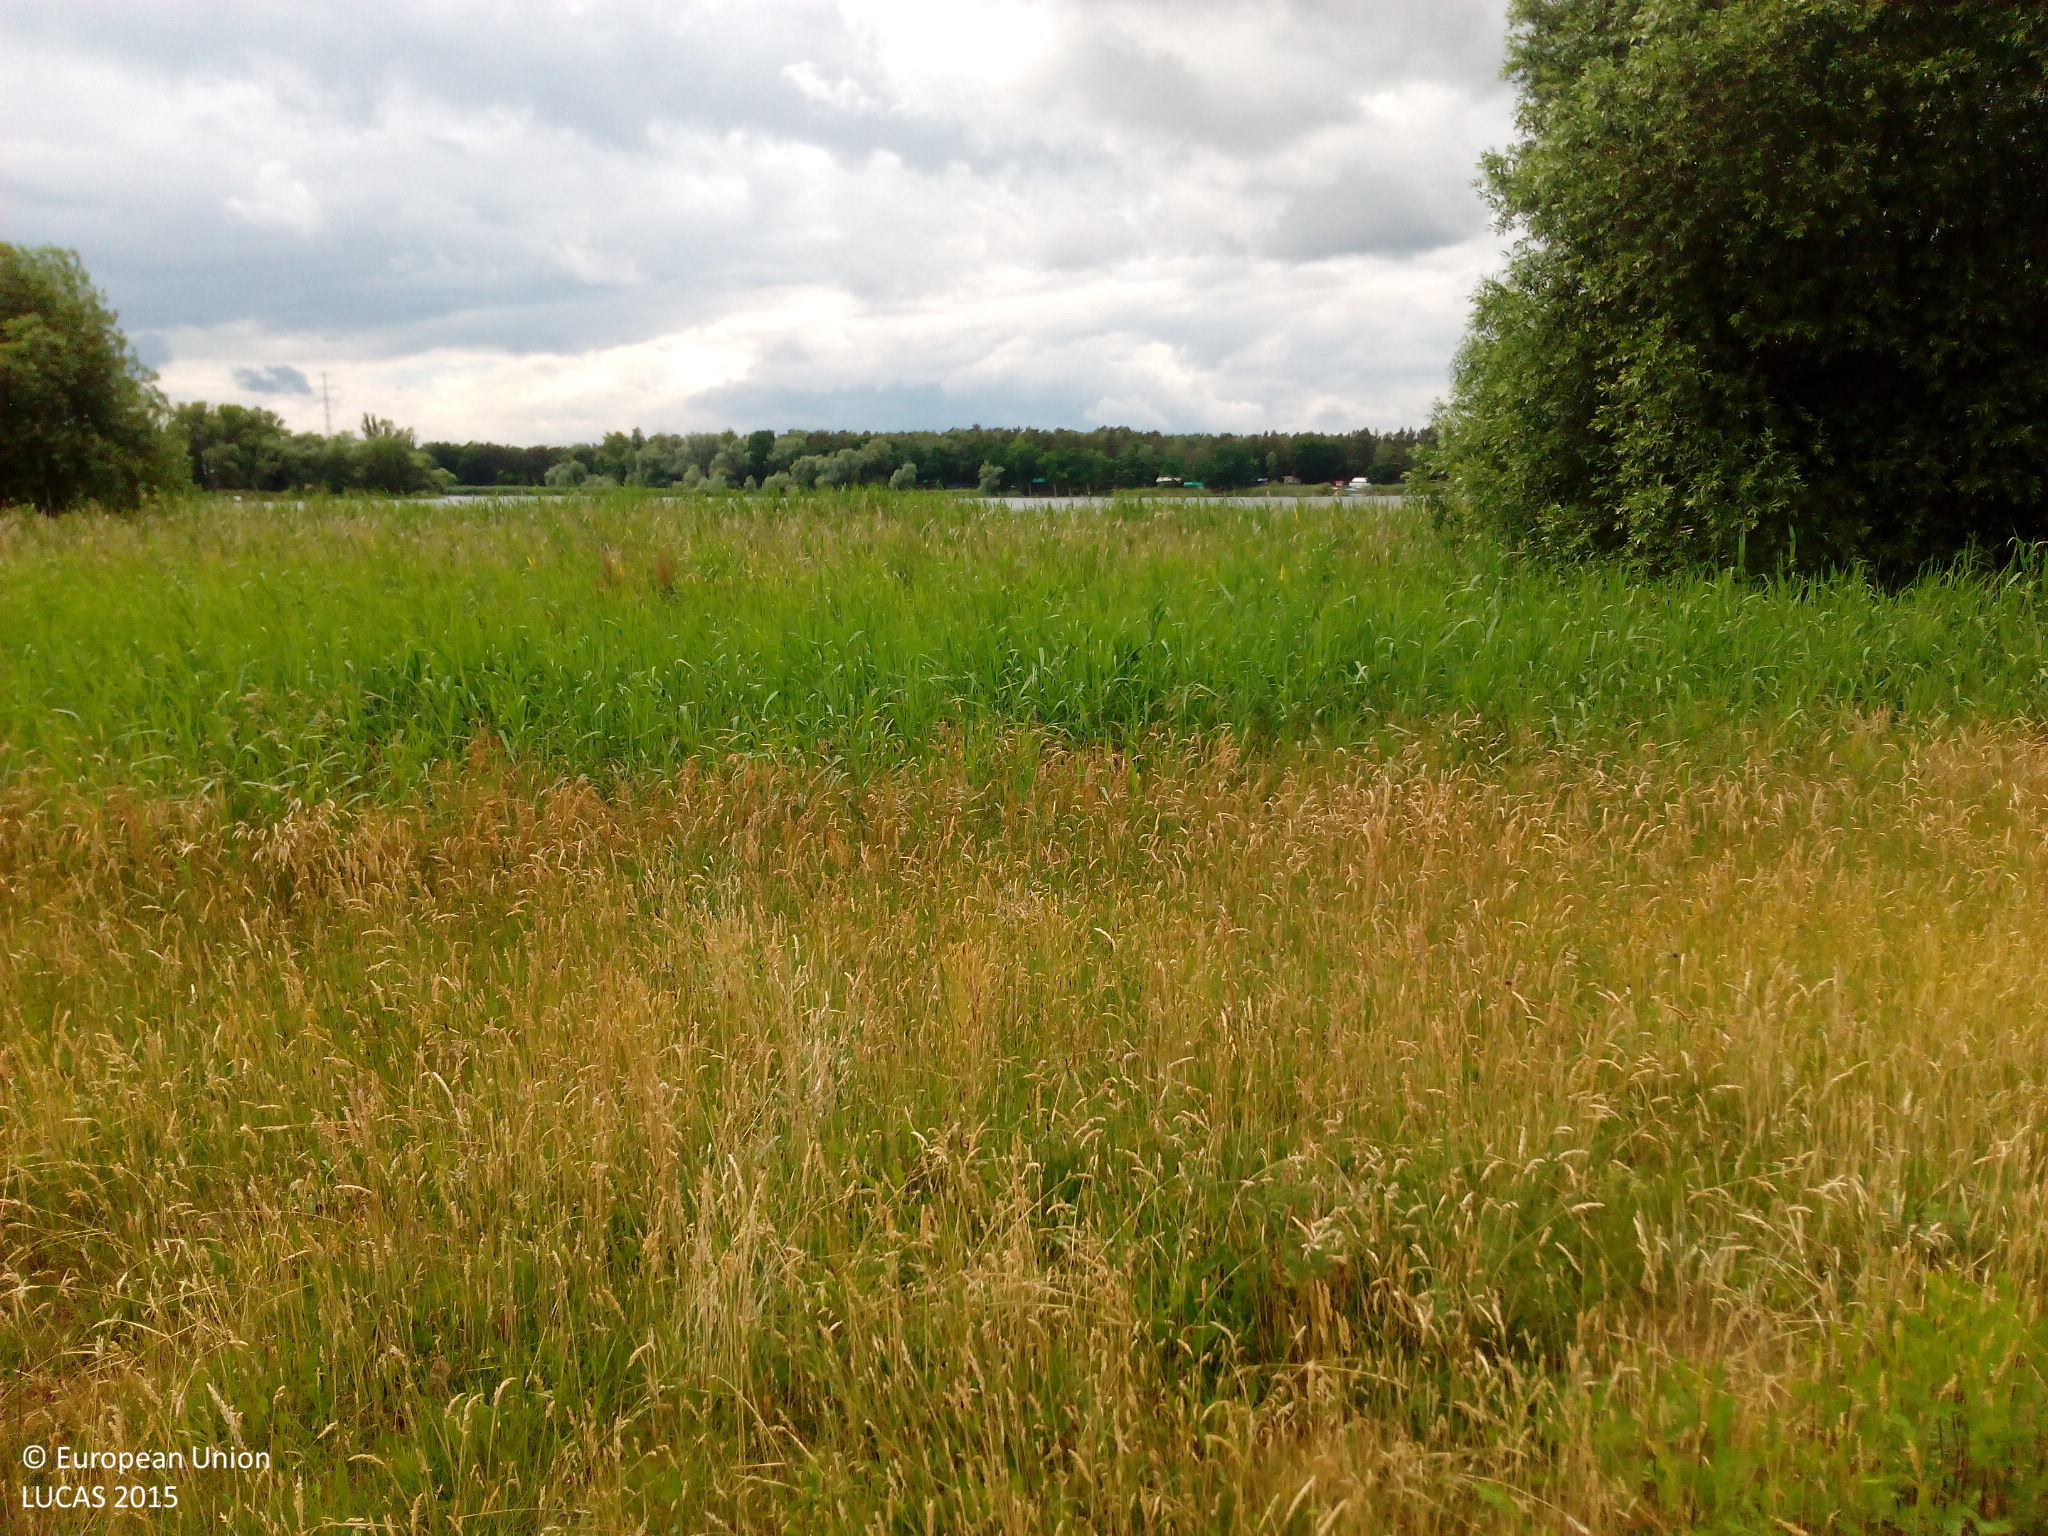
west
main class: Cropland
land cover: Oats
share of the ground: > 75 %
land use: Agriculture (excluding fallow land and kitchen gardens)
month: June
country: DE
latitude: 52.4779
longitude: 12.4584
